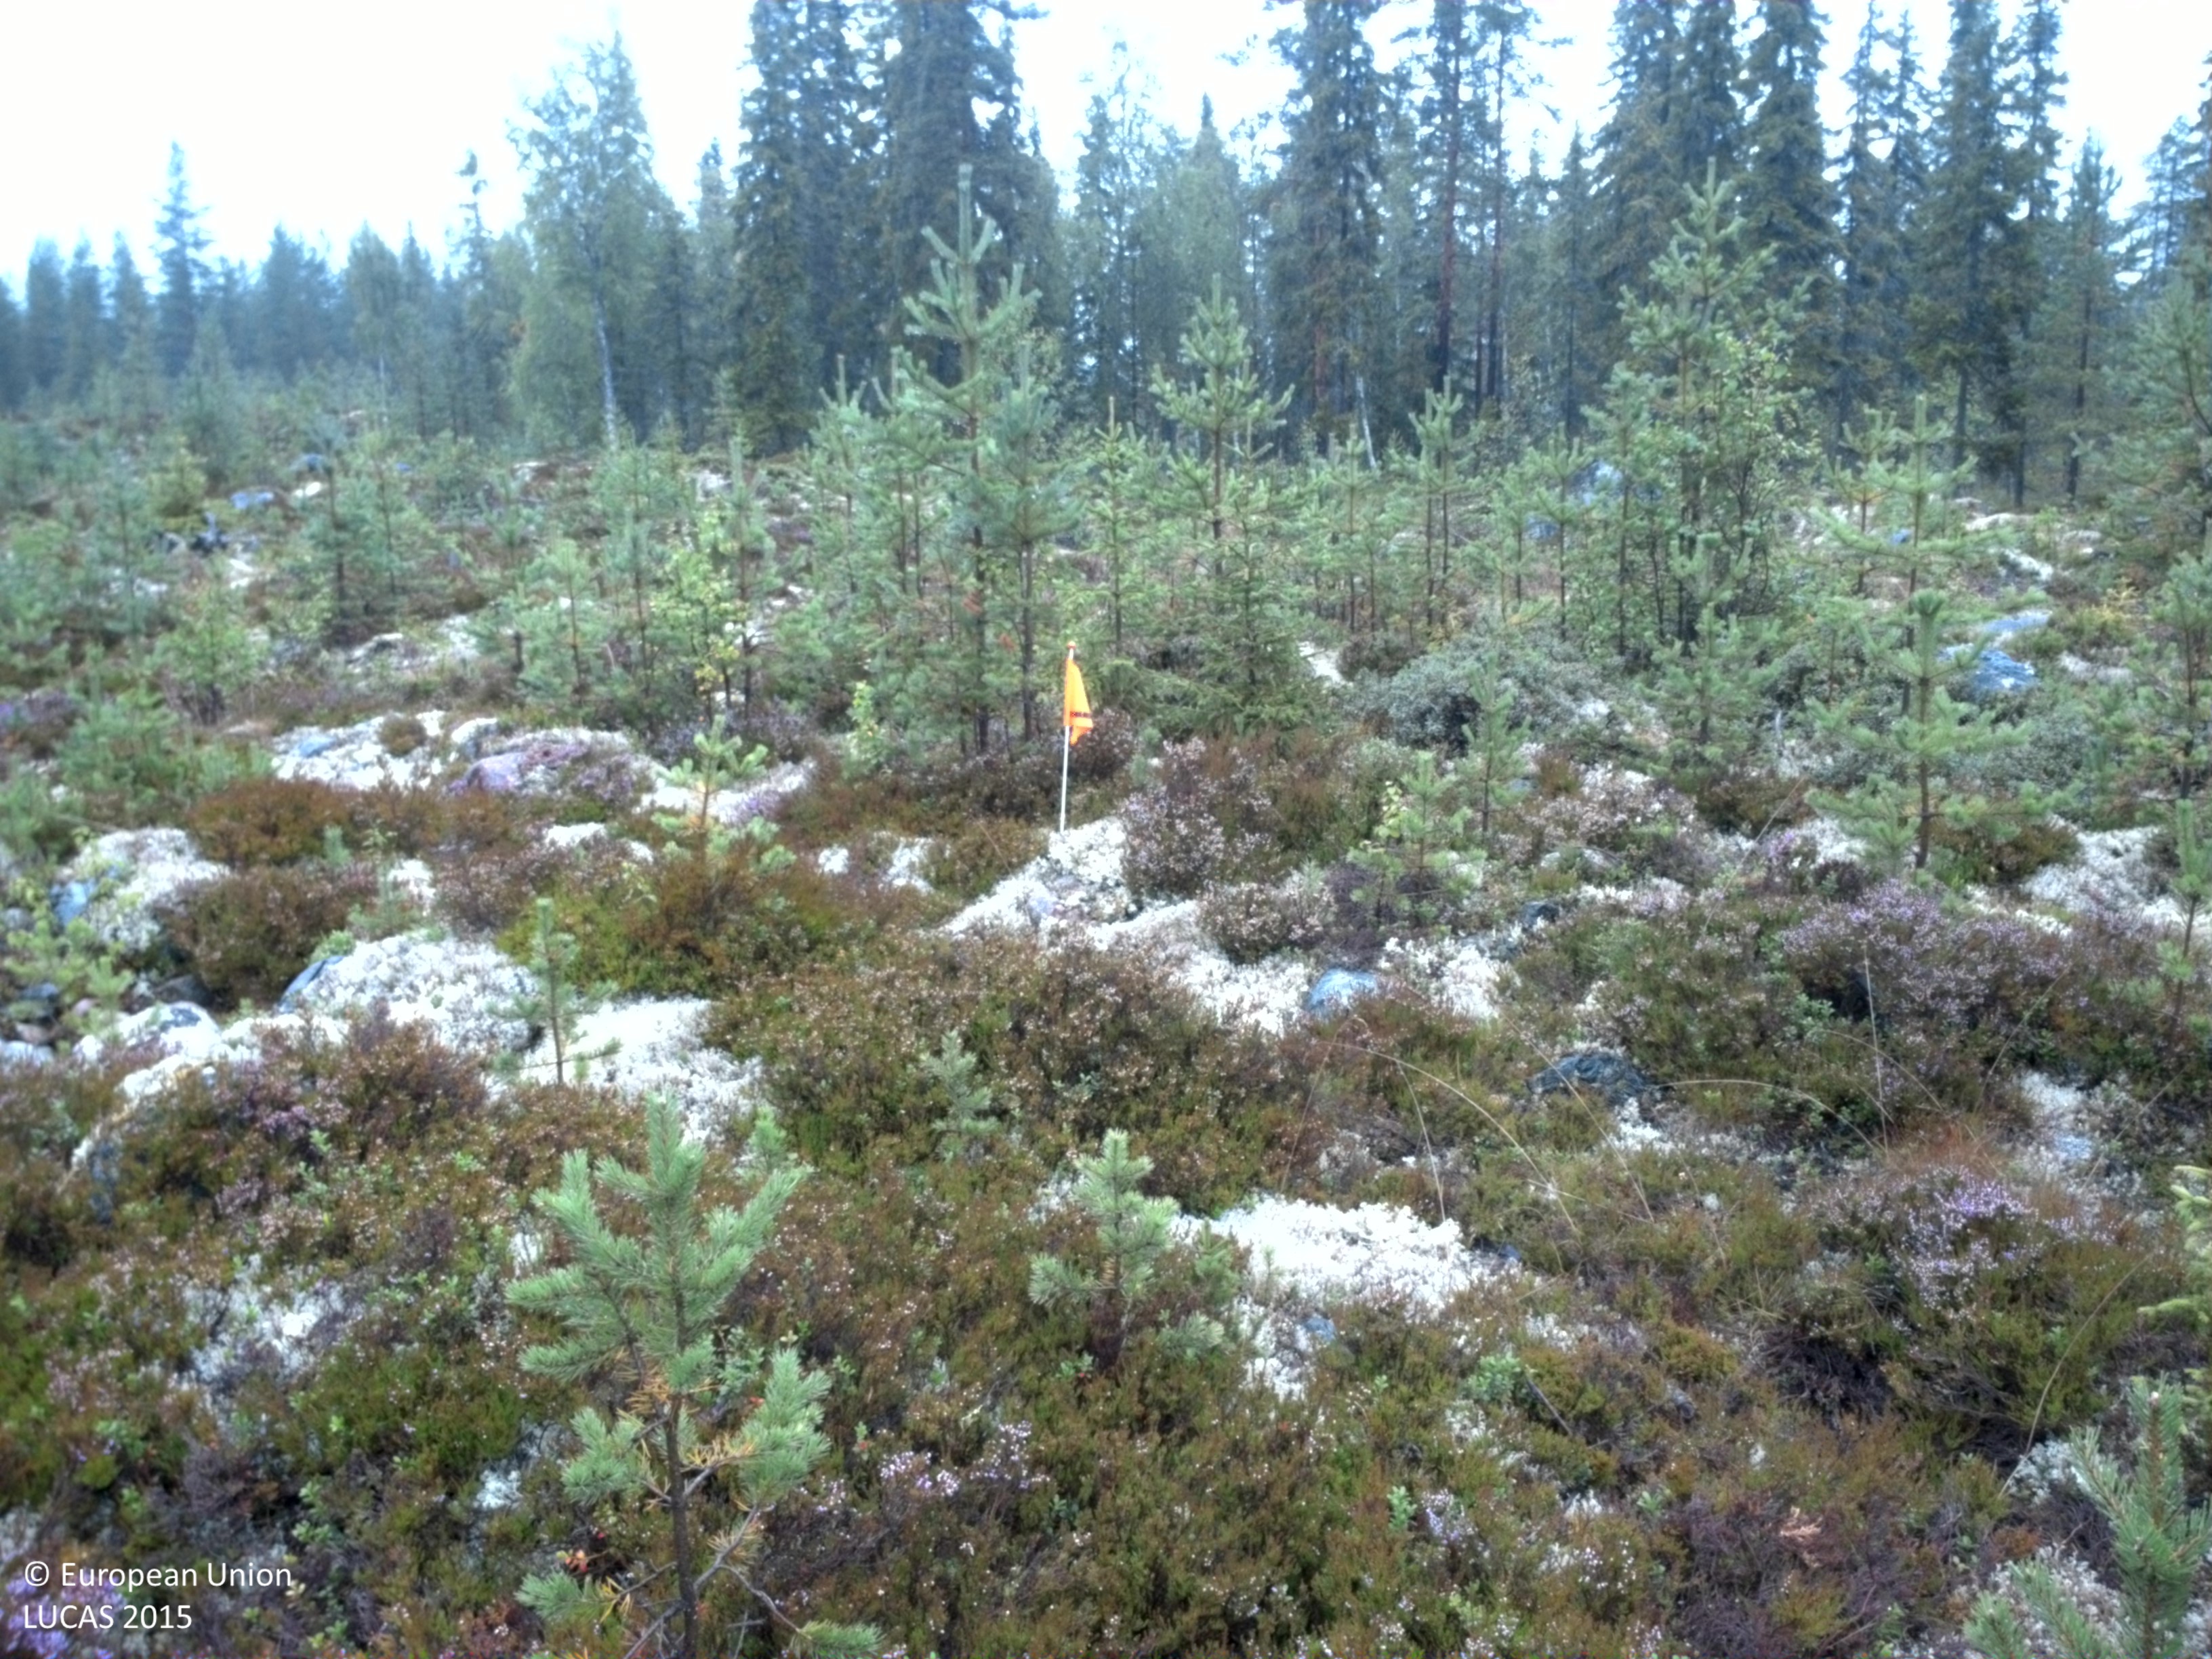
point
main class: Woodland
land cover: Pine dominated coniferous woodland
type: boreal forest
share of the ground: 10 - 25 %
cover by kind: shrubs 65 %, lichens and mosses 20 %, coniferous forest trees 15 %
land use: Forestry
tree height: < 5 m
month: August
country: SE
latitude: 61.7333
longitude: 15.0374
